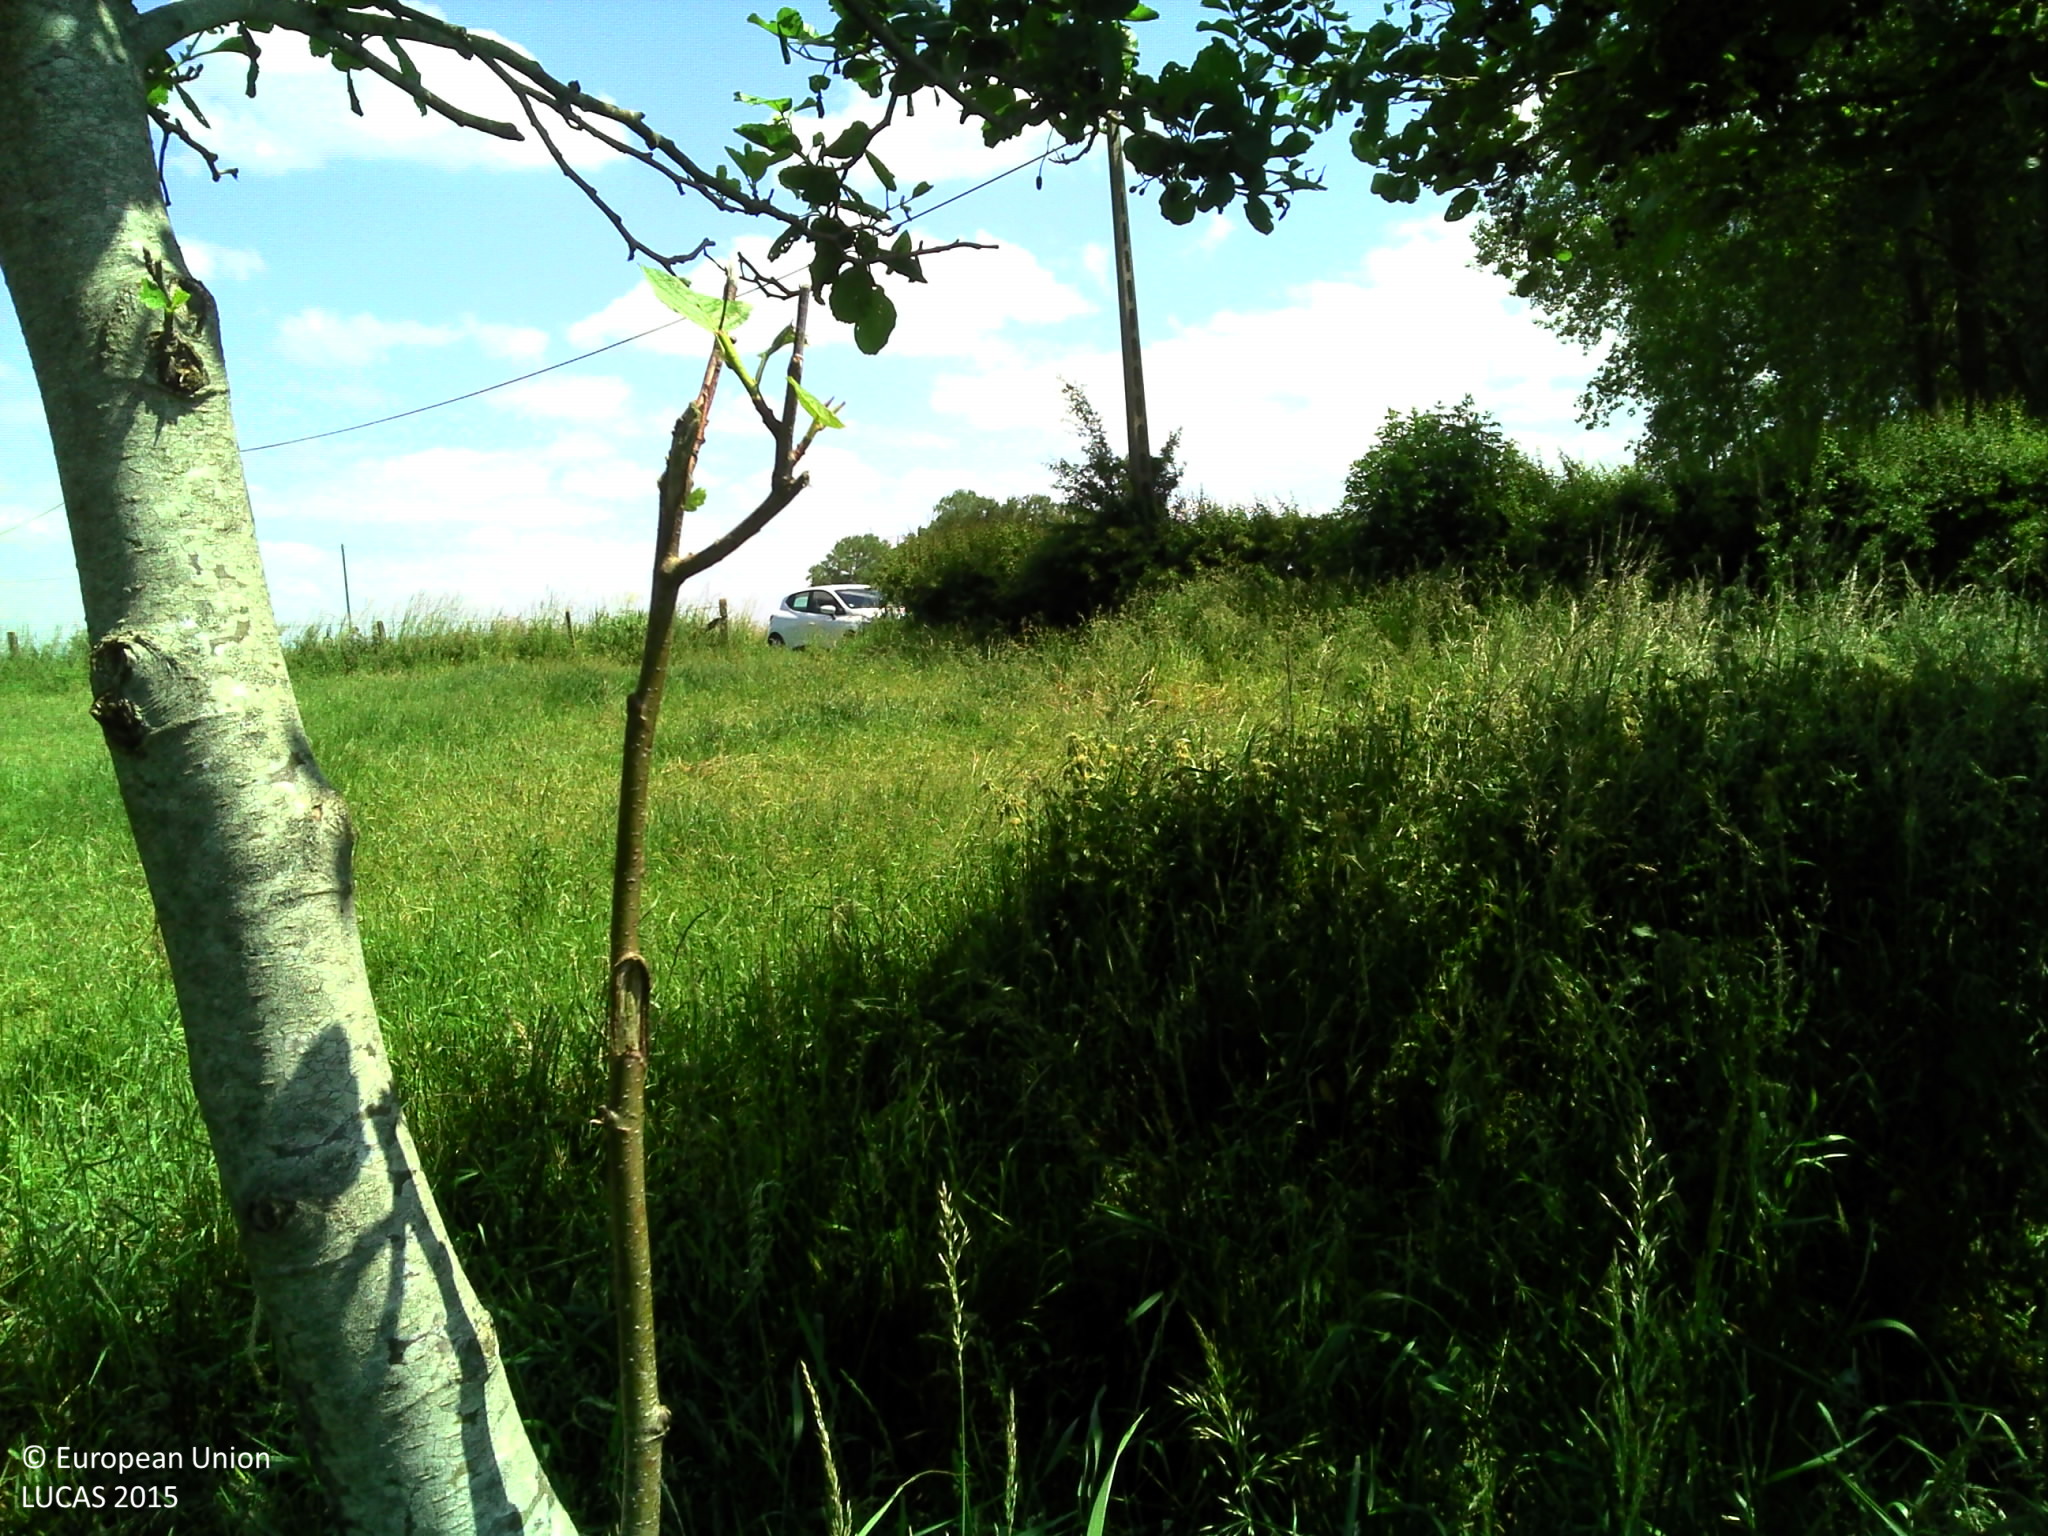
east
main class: Grassland
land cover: Spontaneously vegetated surfaces
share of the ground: > 75 %
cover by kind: herbaceous plants 100 %
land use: Semi-natural and natural areas not in use
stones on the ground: < 10 %
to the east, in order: Spontaneously vegetated surfaces; Lines of trees; Grassland without tree/shrub cover; Fences; Maize; Ditches and canals; Electric lines; Grass margins; Paved roads, cycling and walking lanes; Grass margins; Ditches and canals; Common wheat; Grass margins; Electric lines; Ditches and canals; Paved roads, cycling and walking lanes; Grass margins; Ditches and canals; Maize
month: June
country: BE
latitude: 50.8779
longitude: 2.8117
